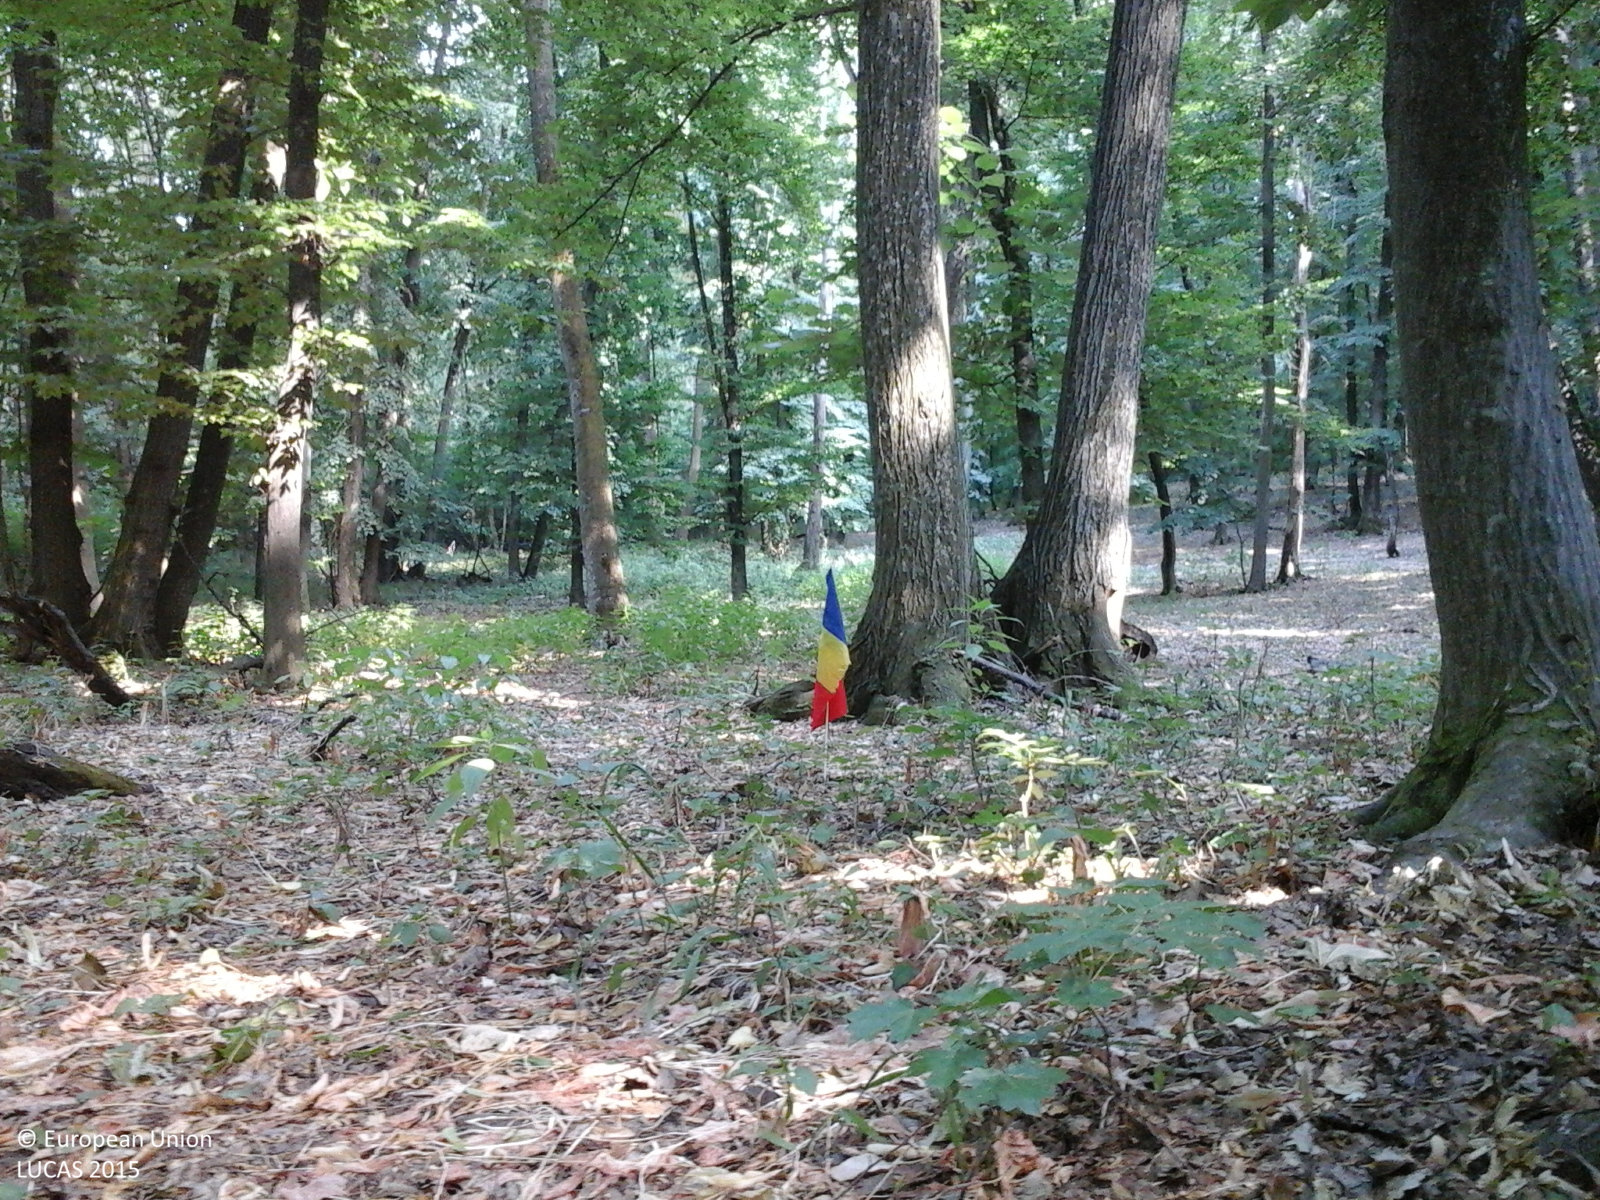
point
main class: Woodland
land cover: Broadleaved woodland
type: beech forest
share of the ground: > 75 %
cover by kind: broadleaved forest trees 100 %
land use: Forestry
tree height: > 5 m
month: June
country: RO
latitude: 46.9968
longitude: 27.9203
